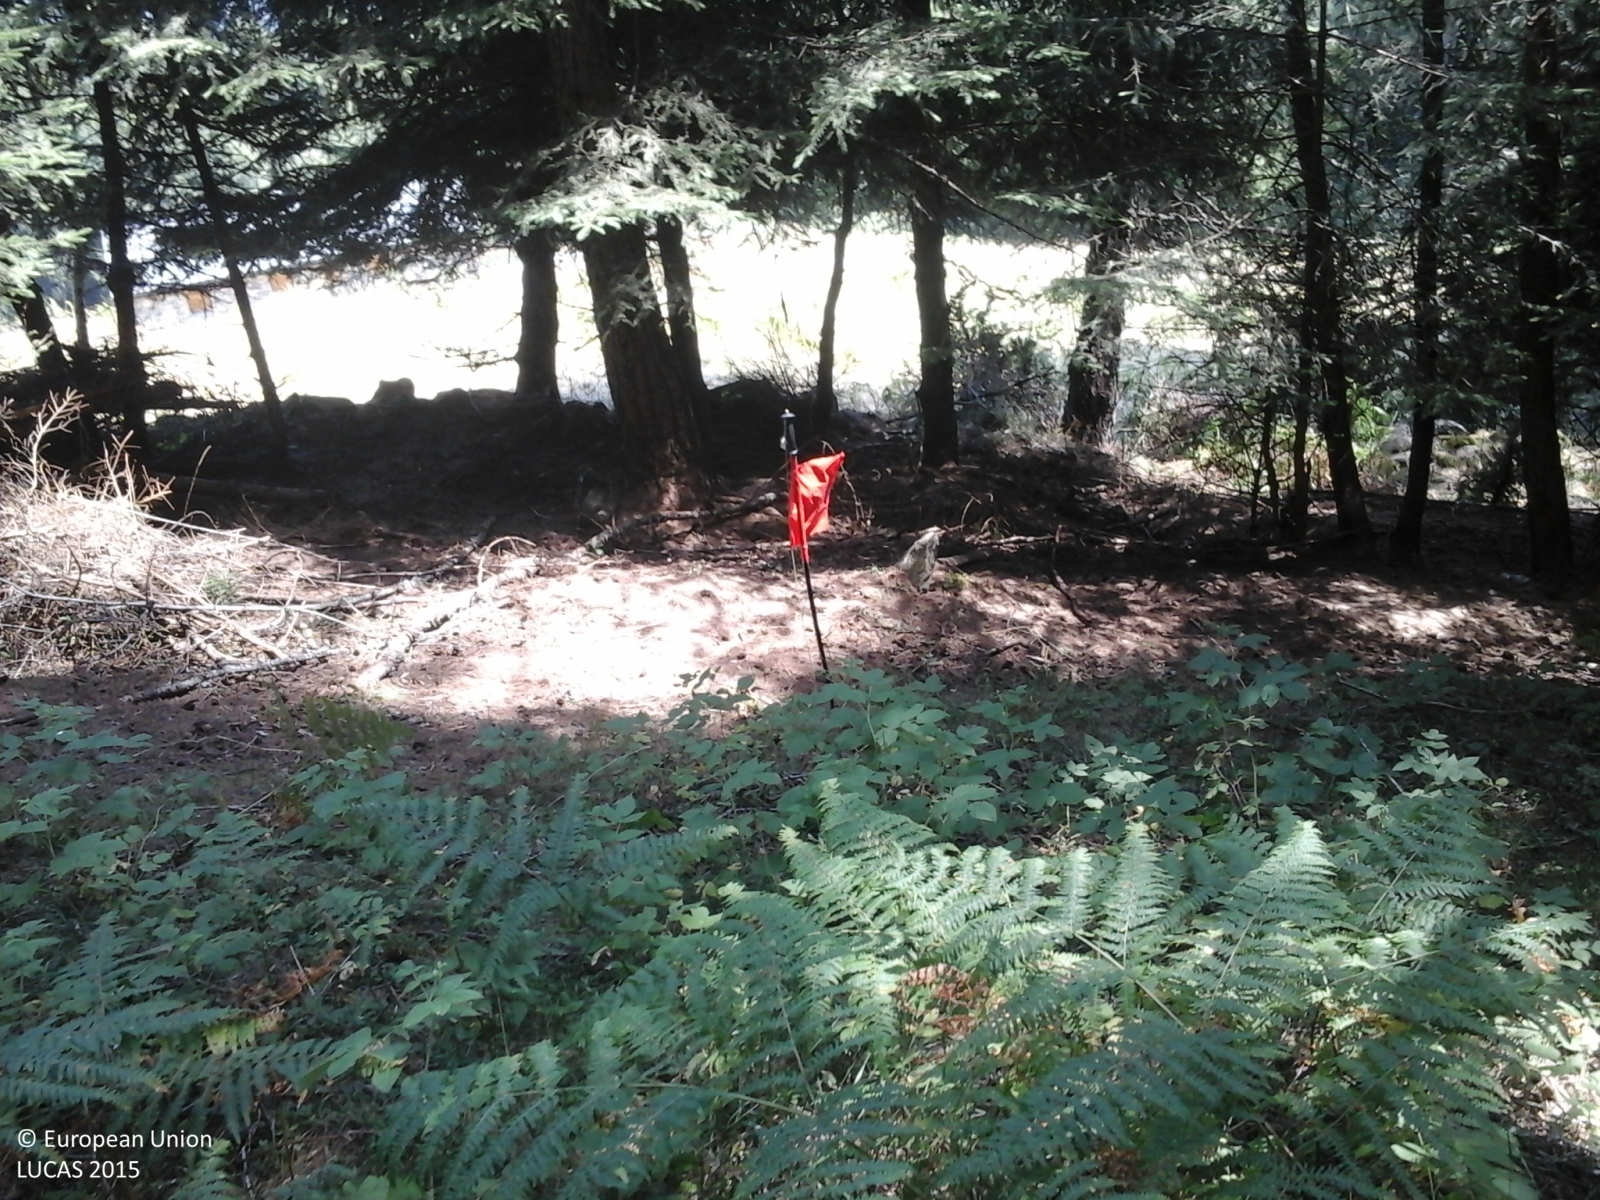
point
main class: Woodland
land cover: Spruce dominated coniferous woodland
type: alpine coniferous forest
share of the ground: > 75 %
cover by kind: coniferous forest trees 100 %
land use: Agriculture (excluding fallow land and kitchen gardens)
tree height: > 5 m
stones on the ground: < 10 %
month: July
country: IT
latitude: 46.1891
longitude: 10.0647
